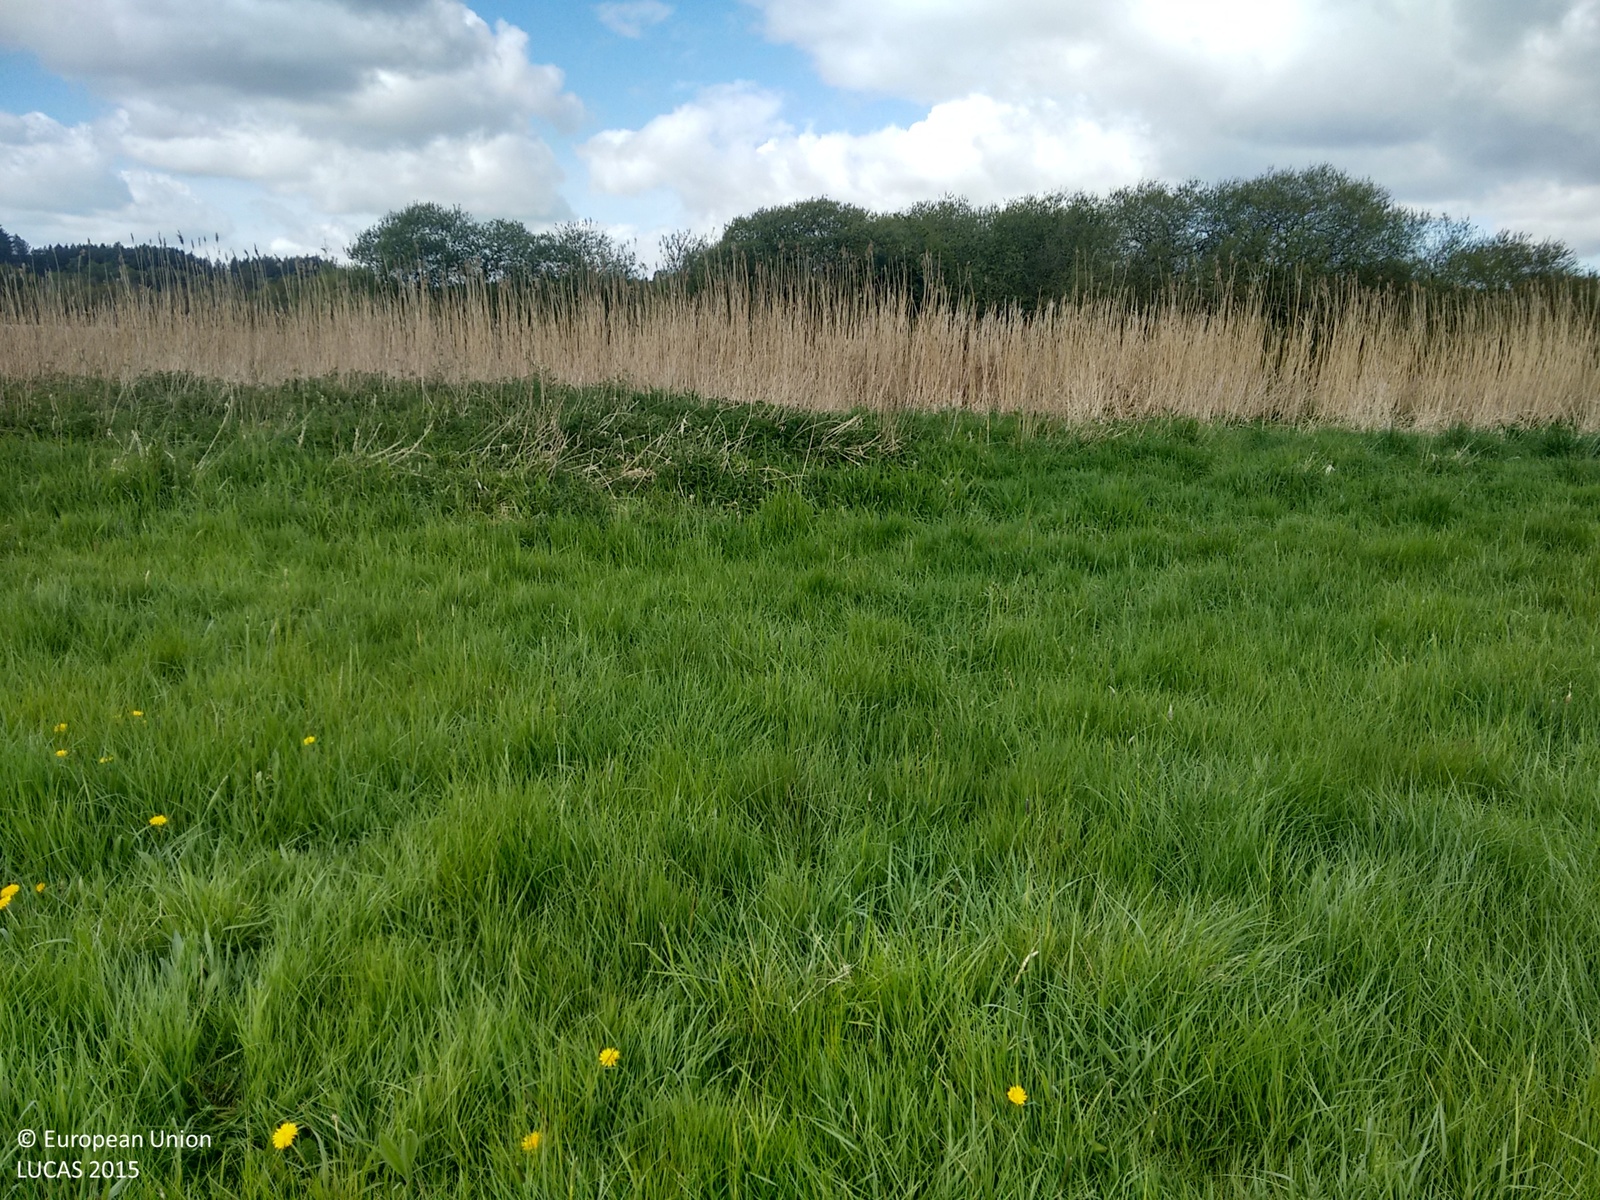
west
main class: Grassland
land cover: Grassland without tree/shrub cover
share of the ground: > 75 %
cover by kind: herbaceous plants 100 %
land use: Agriculture (excluding fallow land and kitchen gardens)
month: April
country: GB
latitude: 50.8591
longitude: -1.8042
